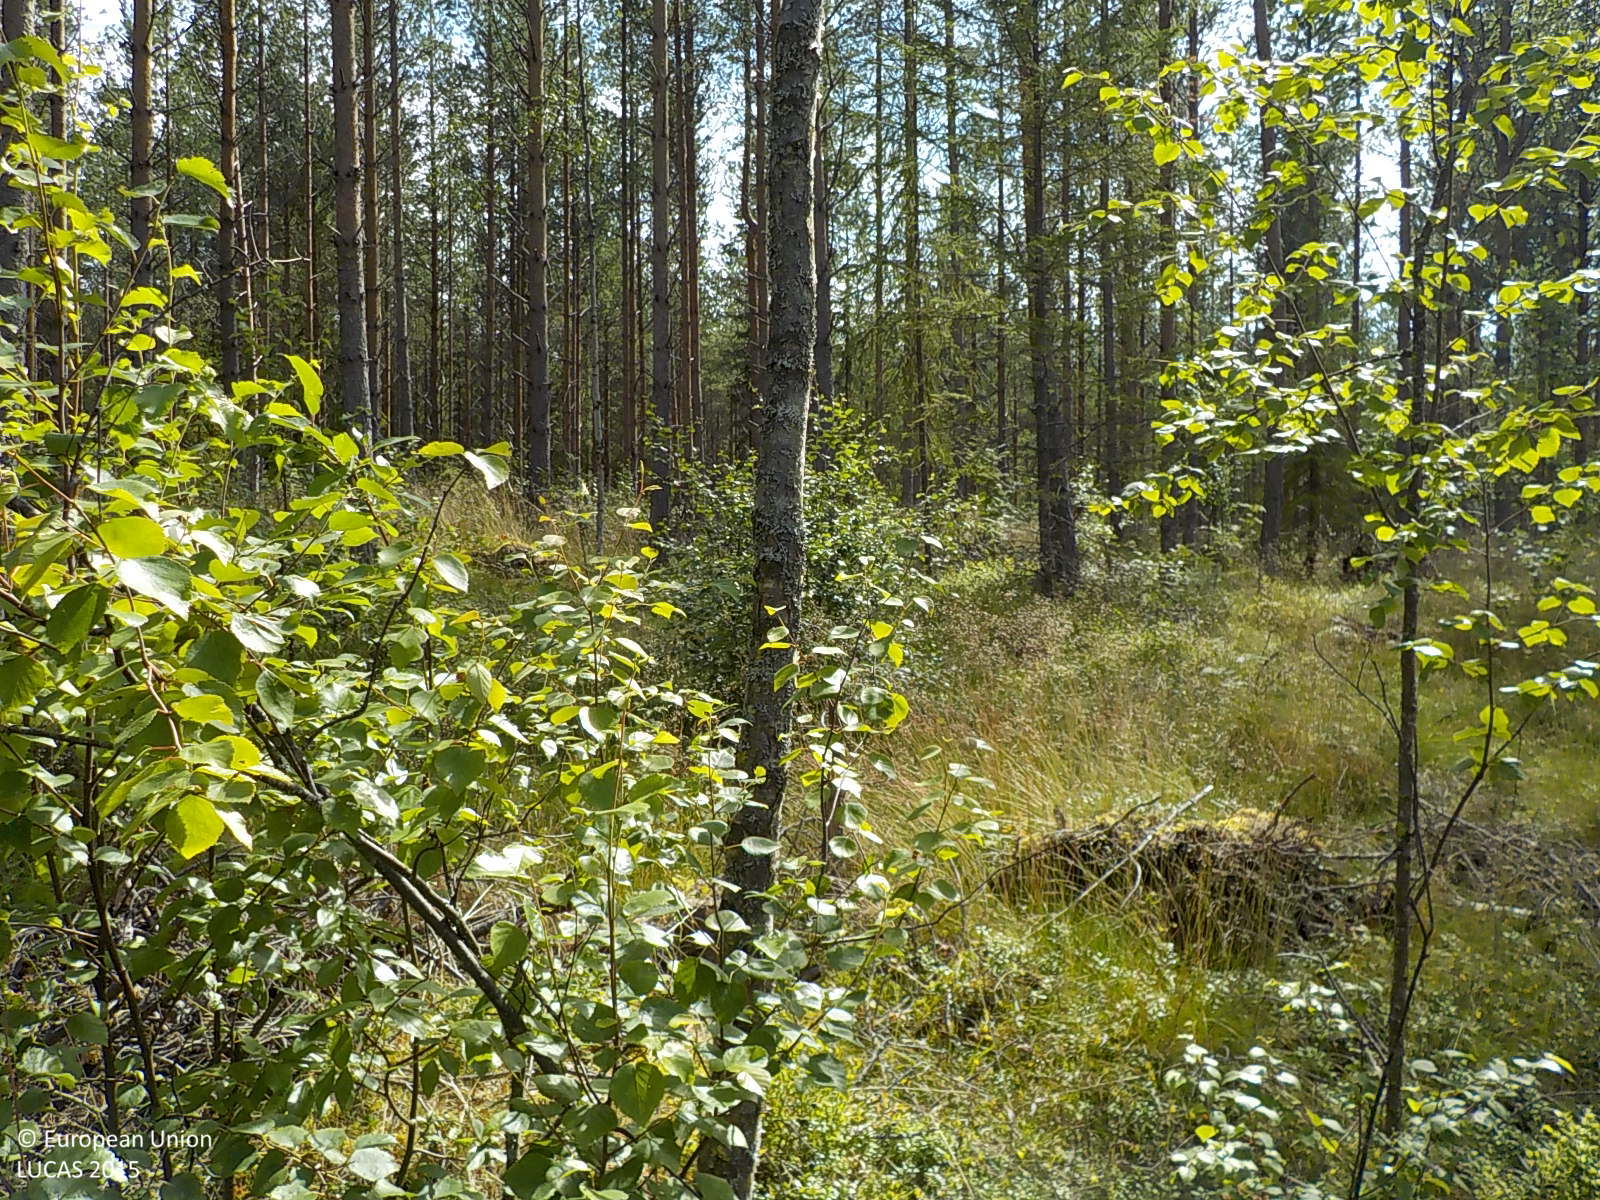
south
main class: Woodland
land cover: Pine dominated mixed woodland
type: boreal forest
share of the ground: > 75 %
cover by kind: coniferous forest trees 60 %, broadleaved forest trees 20 %, shrubs 20 %
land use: Forestry
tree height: > 5 m
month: July
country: SE
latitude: 63.2175
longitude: 17.2360
